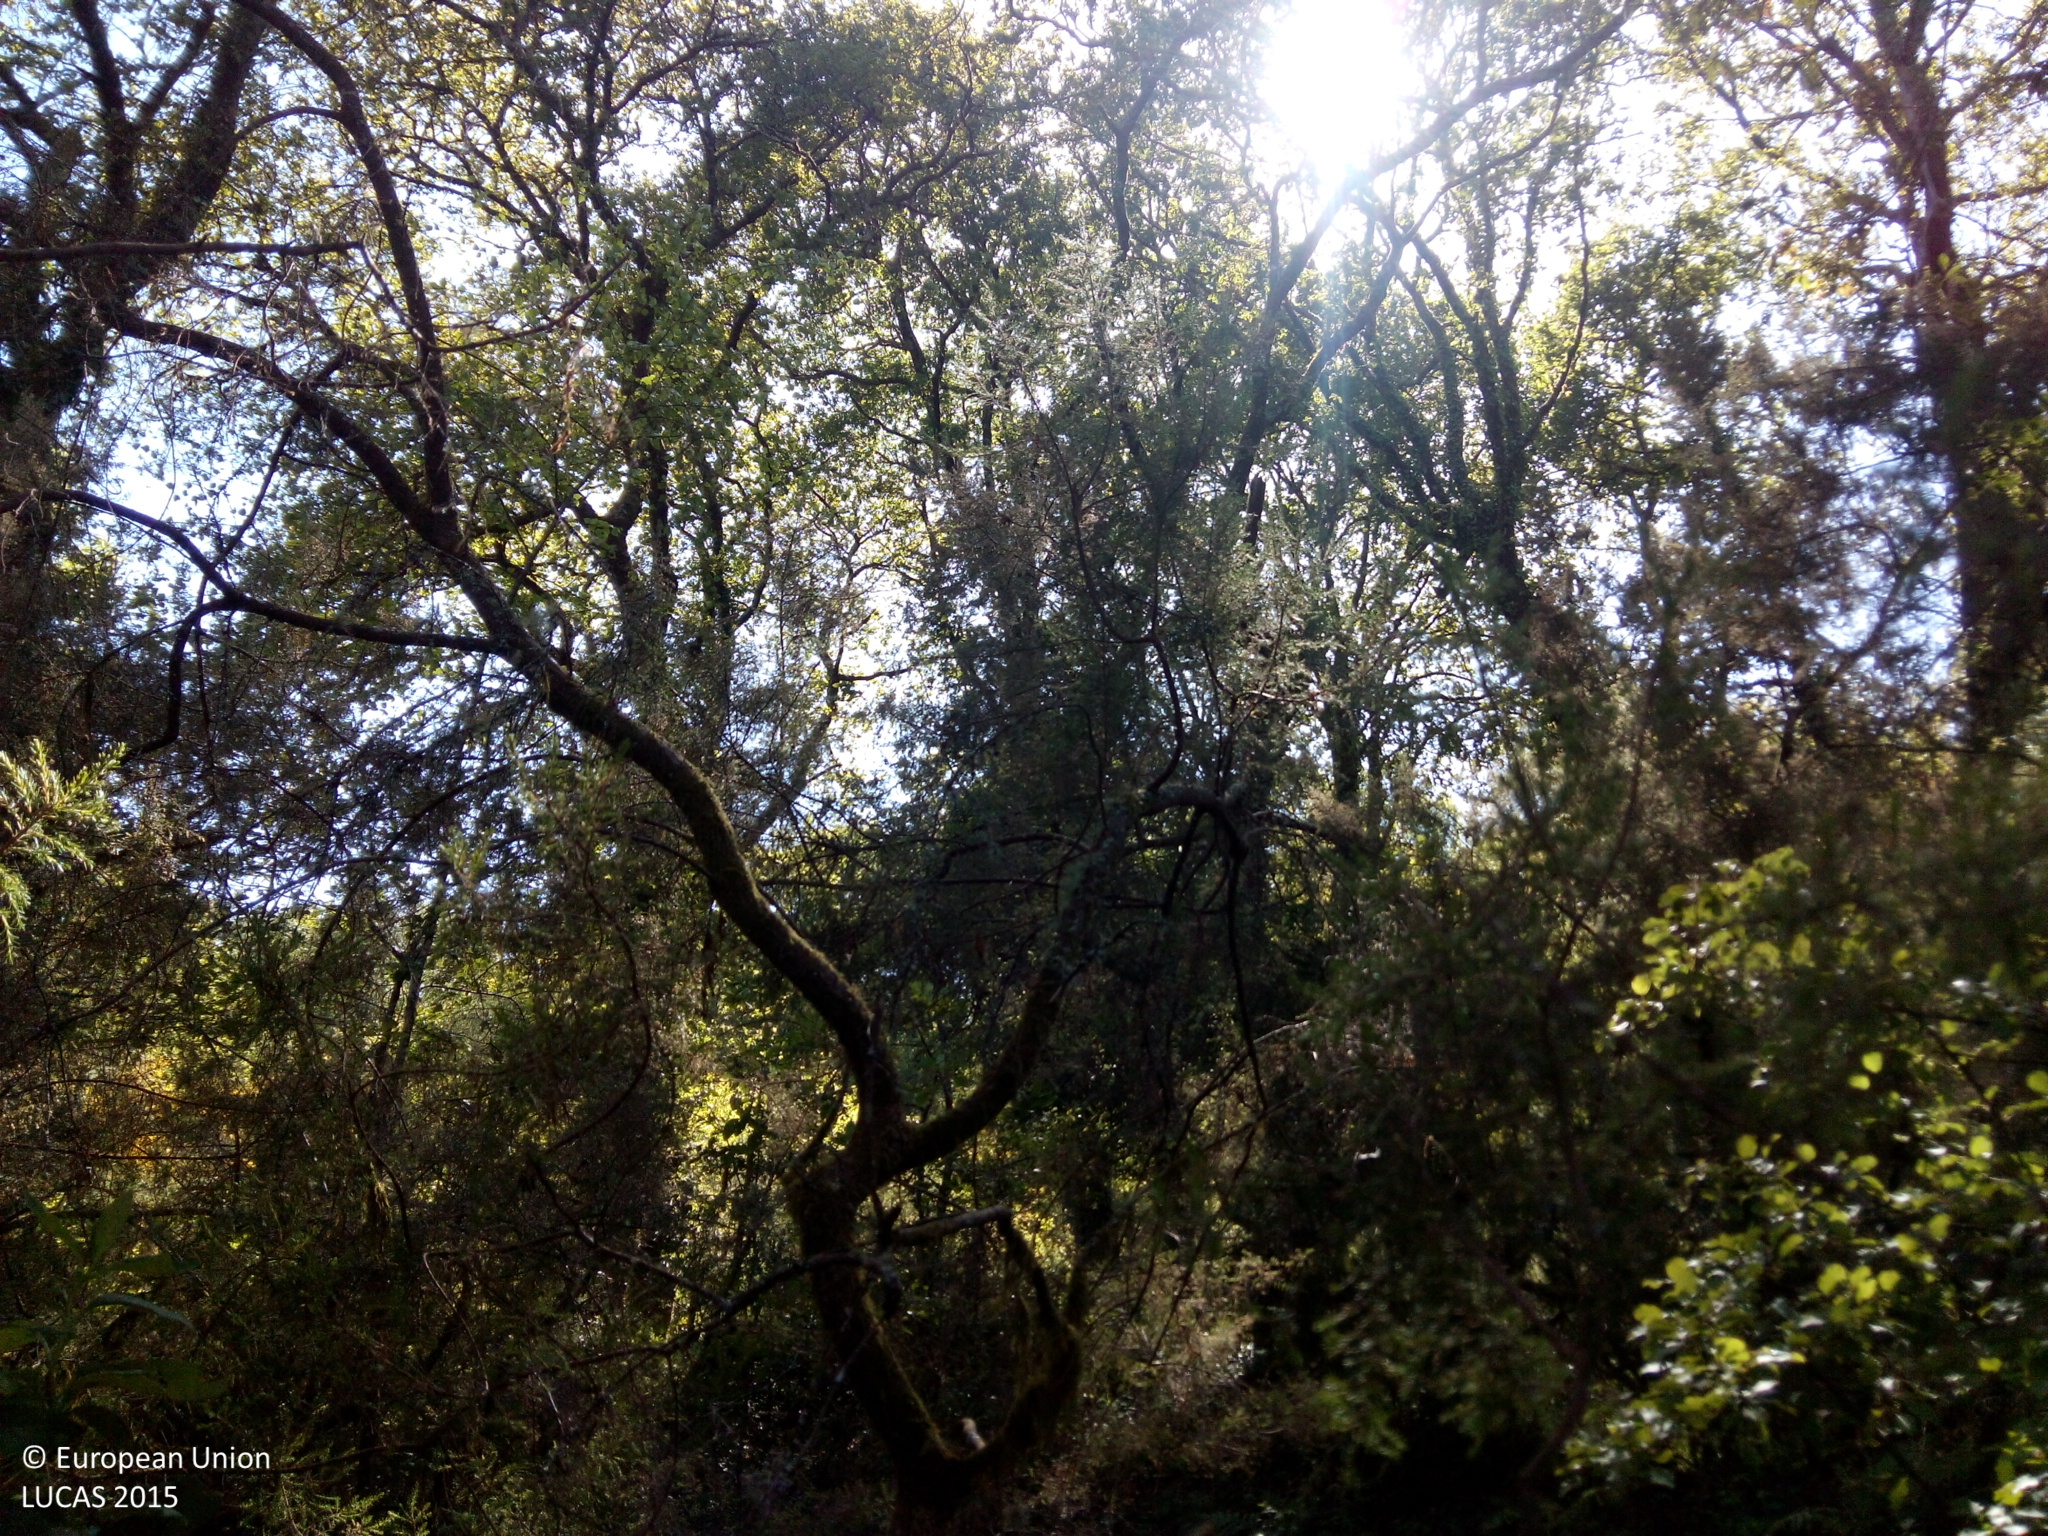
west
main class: Woodland
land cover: Broadleaved woodland
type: acidophilous oak and oak-birch forest
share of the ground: > 75 %
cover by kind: broadleaved forest trees 100 %
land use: Forestry
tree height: > 5 m
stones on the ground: 10 - 25 %
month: May
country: ES
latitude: 42.6364
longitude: -8.3767
